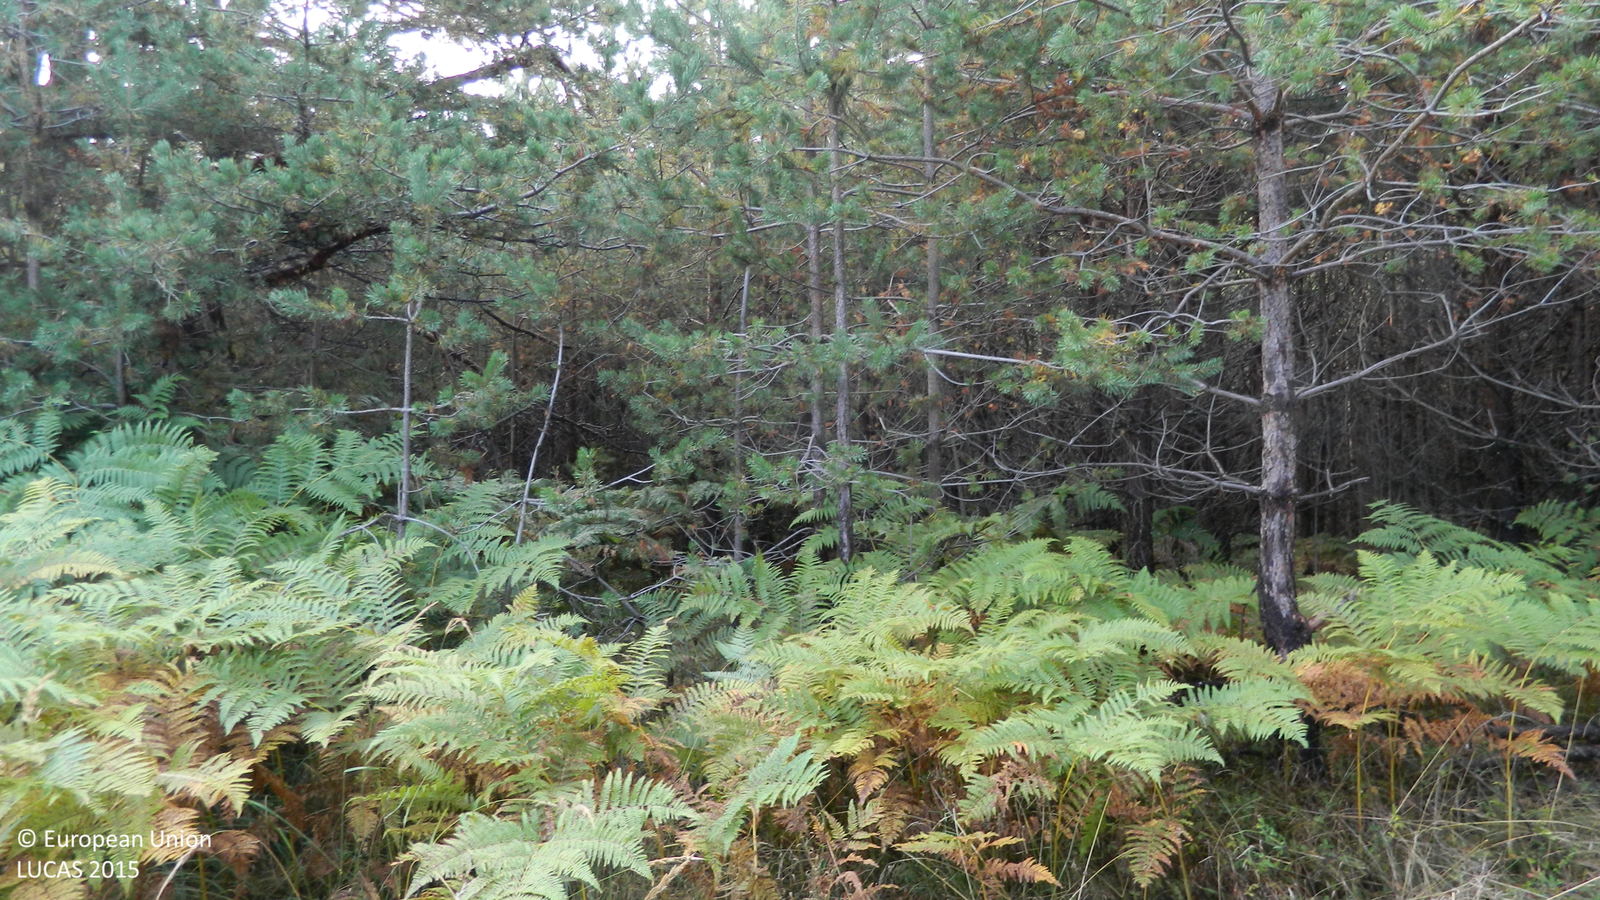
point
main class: Woodland
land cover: Pine dominated coniferous woodland
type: alpine coniferous forest
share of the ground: > 75 %
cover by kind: coniferous forest trees 100 %
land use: Forestry
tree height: > 5 m
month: October
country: BG
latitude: 41.7040
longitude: 24.9389
